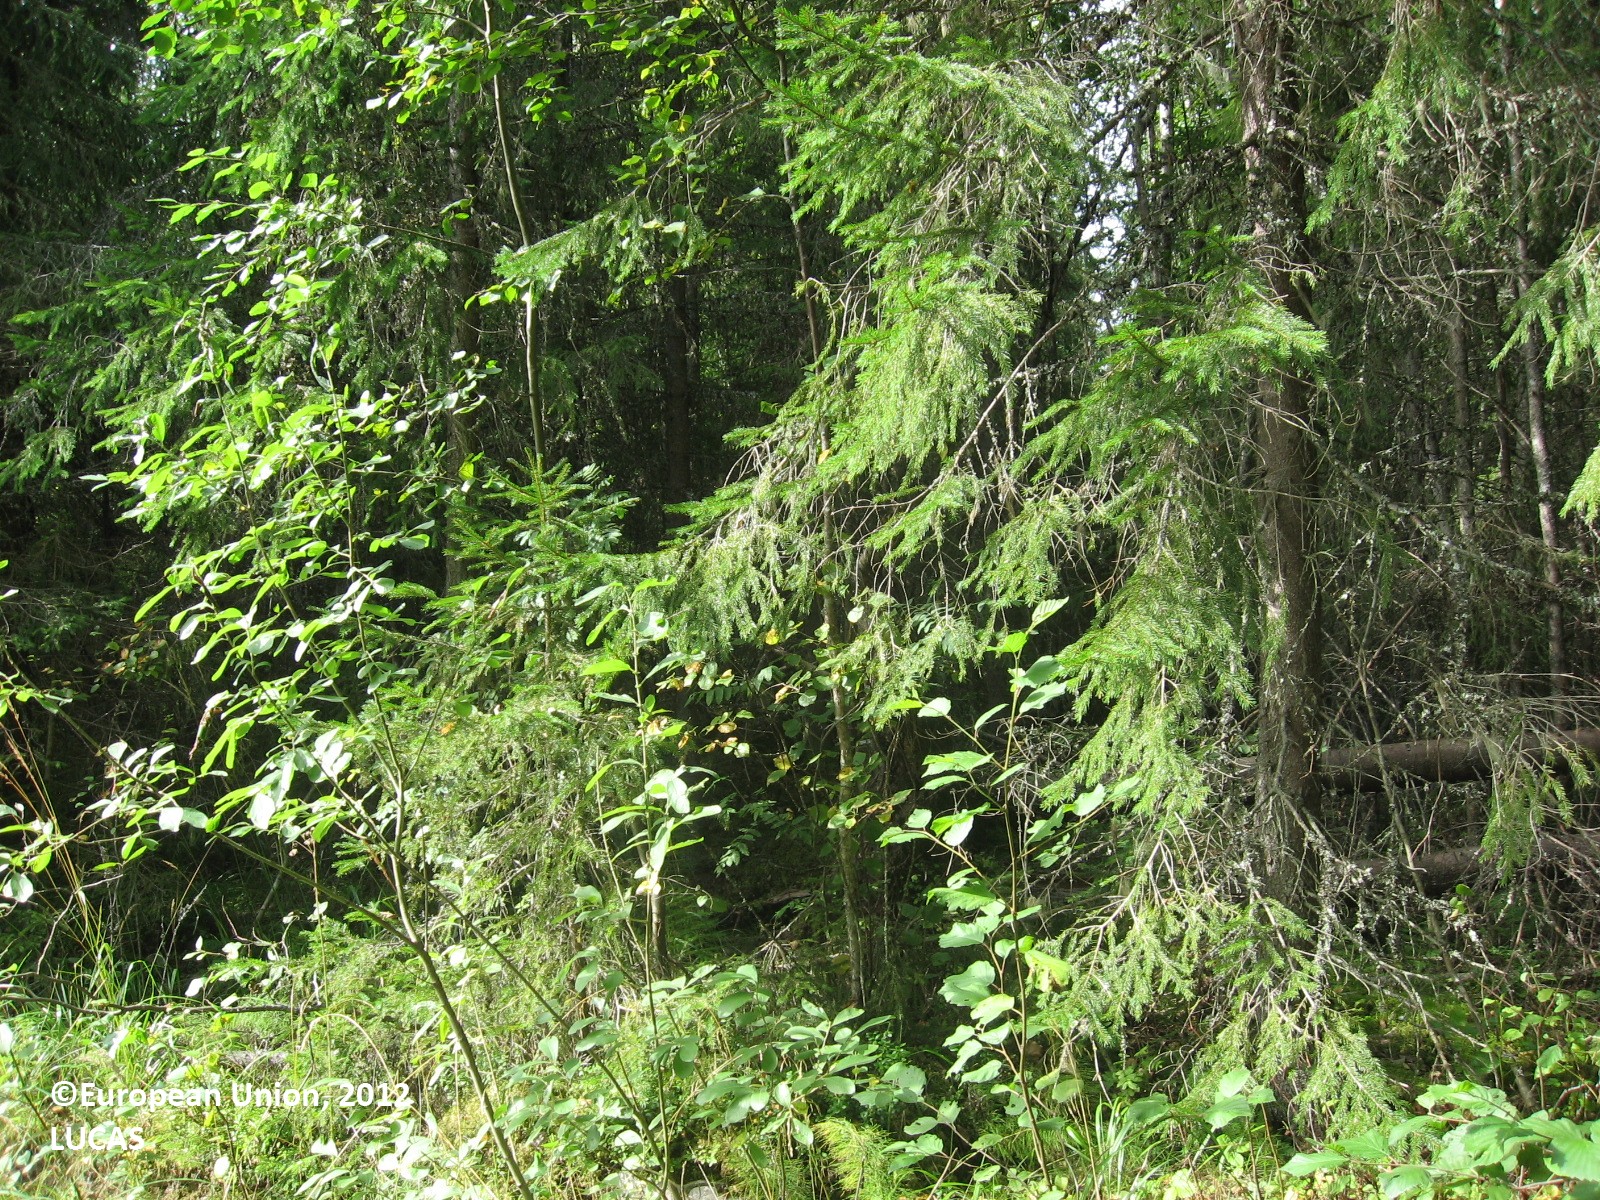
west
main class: Woodland
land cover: Spruce dominated mixed woodland
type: boreal forest
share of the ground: > 75 %
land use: Forestry
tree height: > 5 m
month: August
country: FI
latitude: 61.3323
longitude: 24.8892
